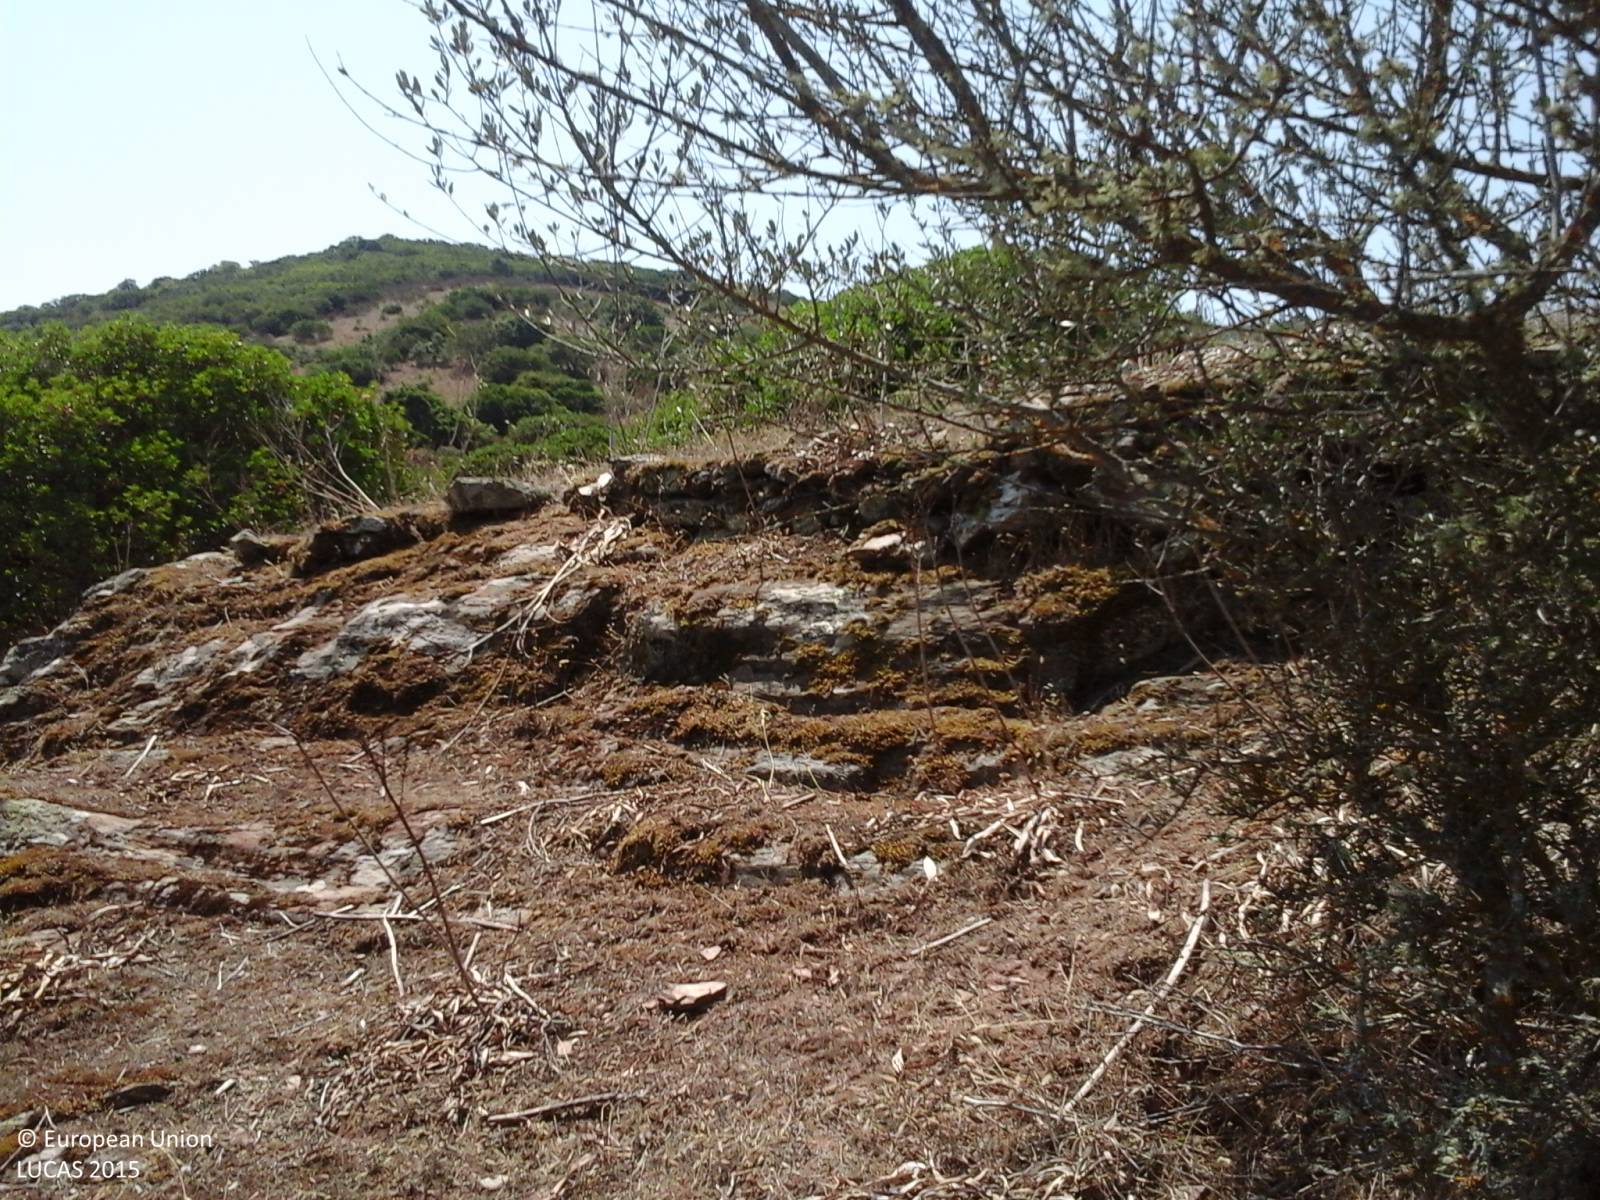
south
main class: Woodland
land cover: Broadleaved woodland
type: broadleaved evergreen forest
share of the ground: 50 - 75 %
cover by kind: broadleaved forest trees 100 %
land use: Forestry
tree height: < 5 m
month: July
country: IT
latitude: 39.9528
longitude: 8.8475
